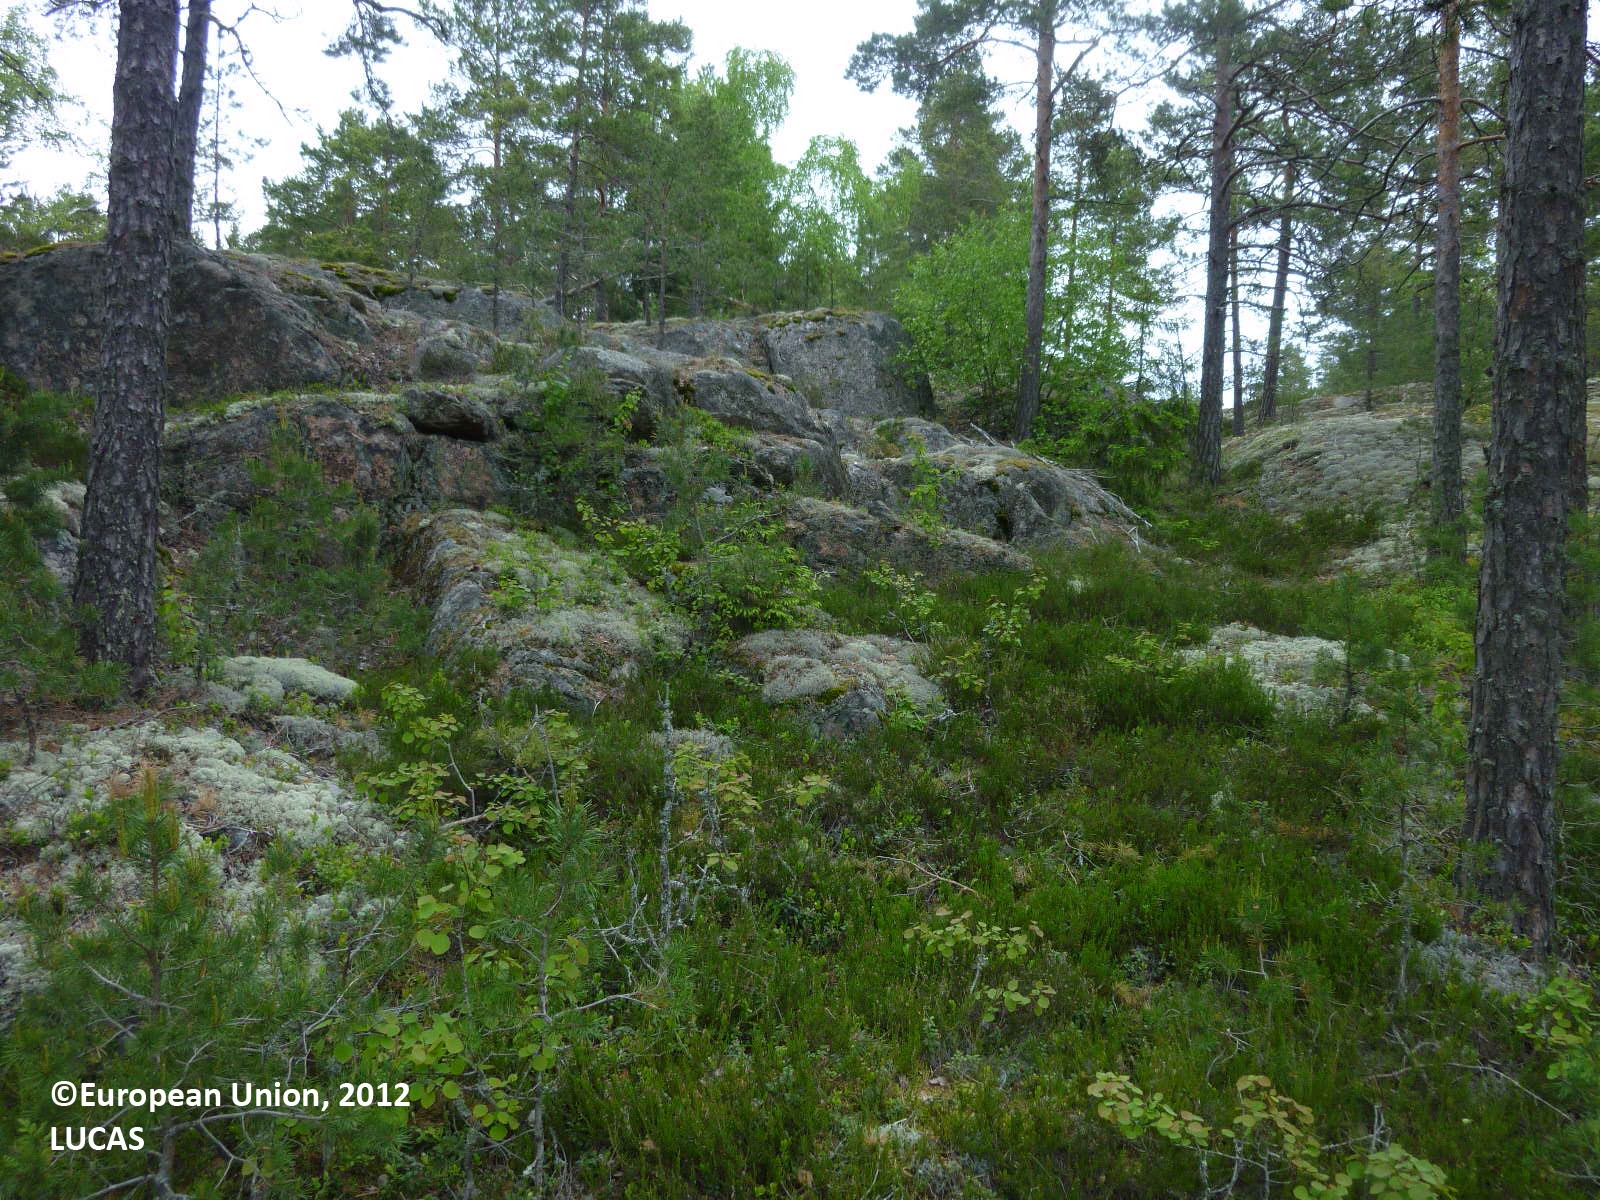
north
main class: Woodland
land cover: Pine dominated coniferous woodland
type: boreal forest
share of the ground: 25 - 50 %
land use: Forestry
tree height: > 5 m
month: June
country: FI
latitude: 60.3763
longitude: 22.6417
